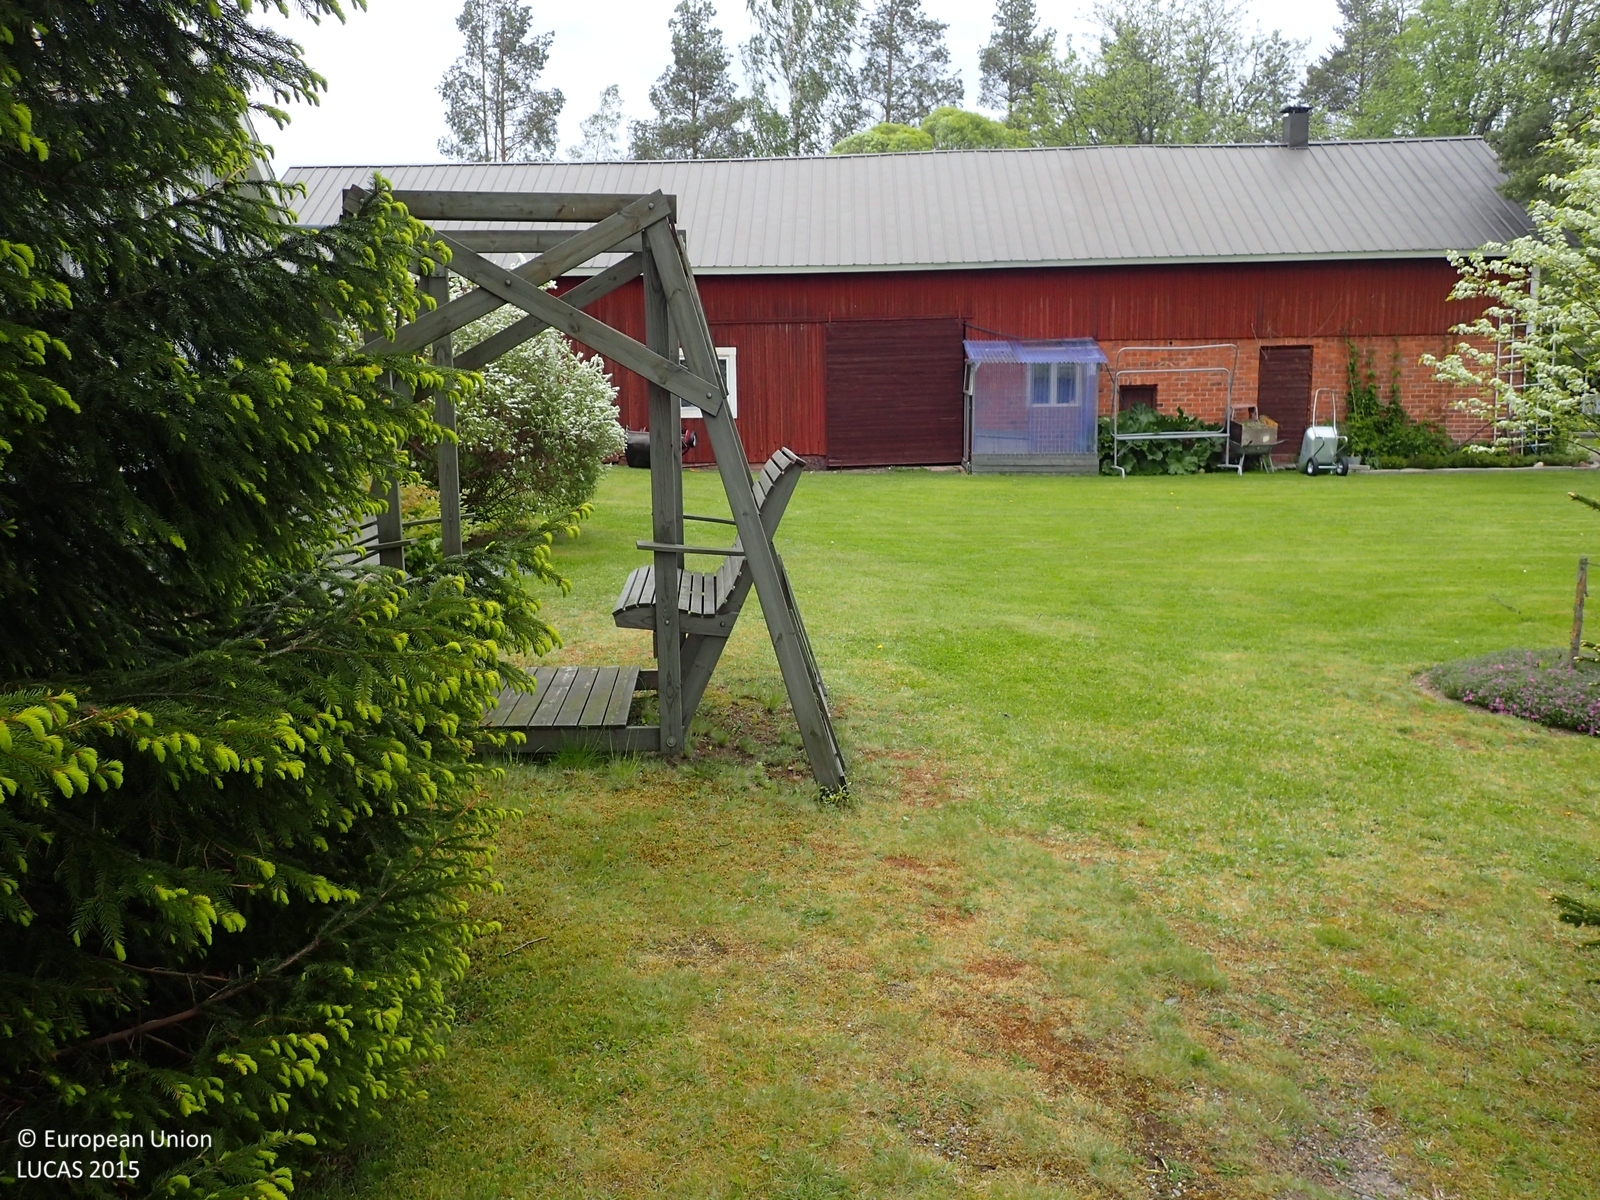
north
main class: Woodland
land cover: Spruce dominated mixed woodland
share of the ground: 10 - 25 %
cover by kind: herbaceous plants 65 %, coniferous forest trees 5 %, broadleaved forest trees 5 %
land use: Residential
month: June
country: FI
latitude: 62.2672
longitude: 21.6623
